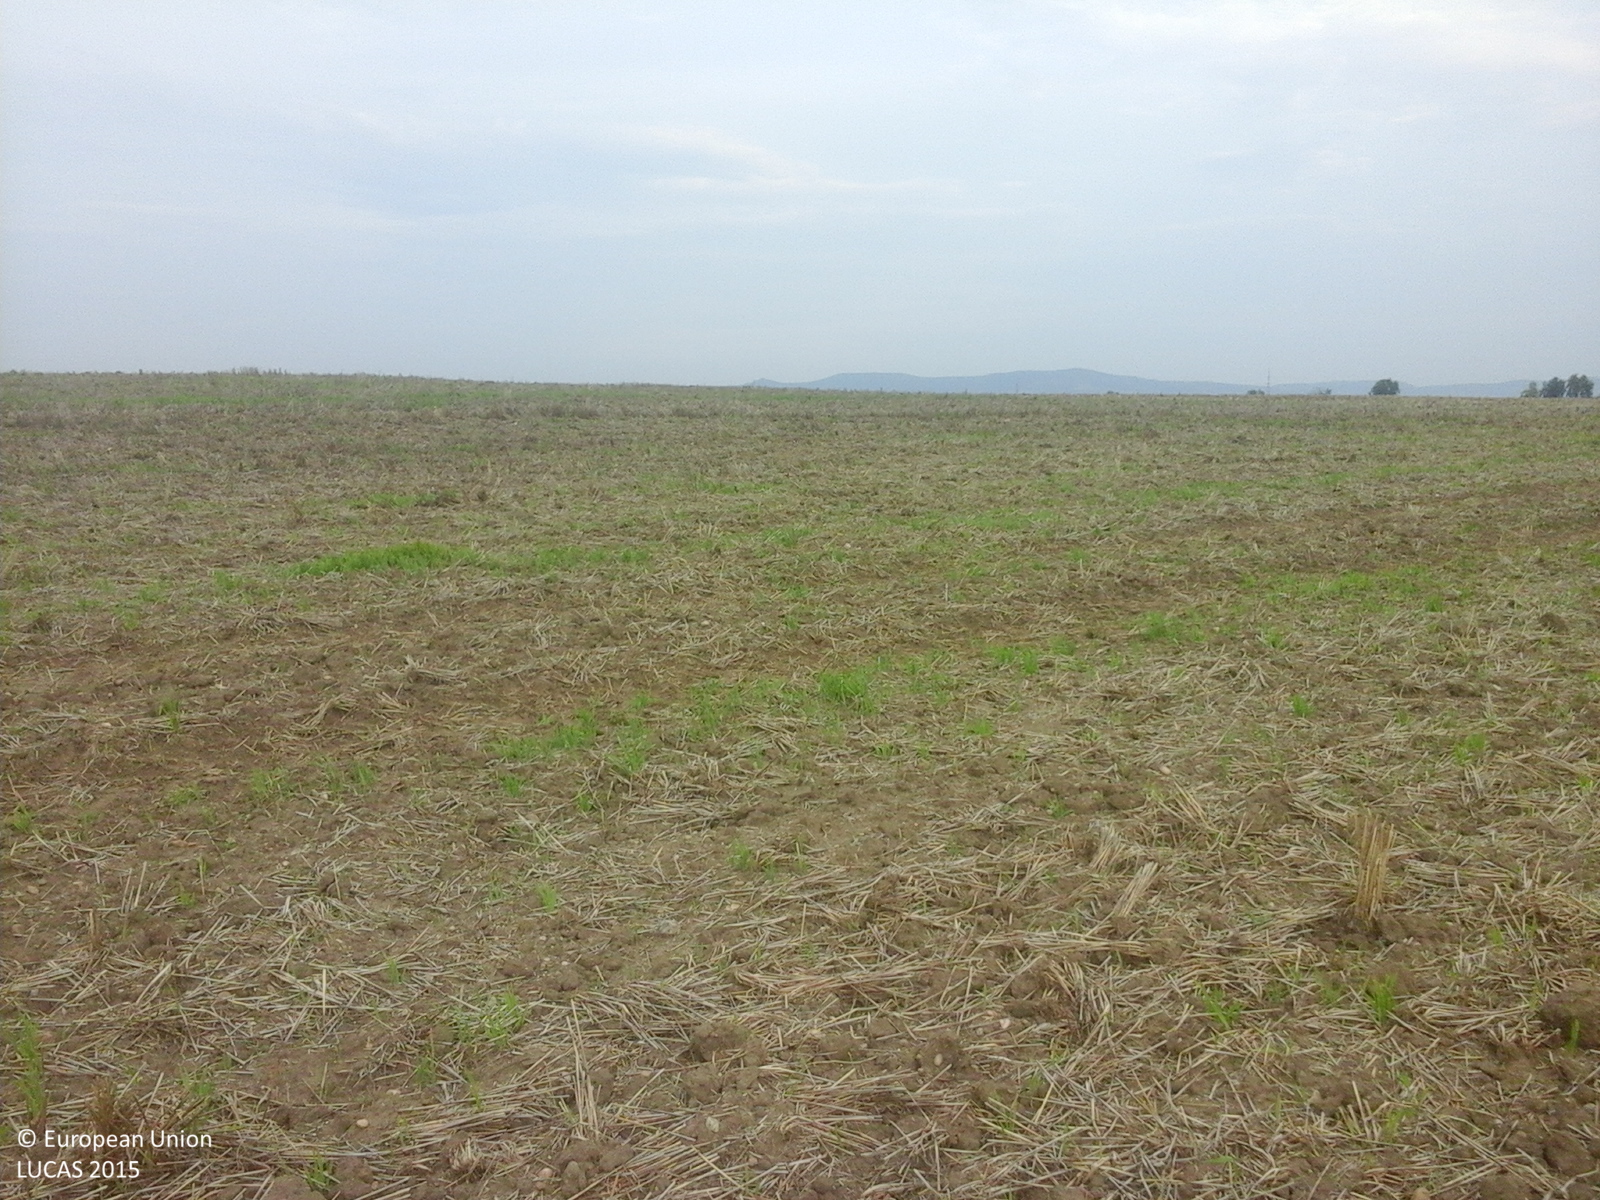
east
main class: Cropland
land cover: Common wheat
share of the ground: < 10 %
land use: Agriculture (excluding fallow land and kitchen gardens)
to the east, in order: Common wheat
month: August
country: RO
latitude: 46.2215
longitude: 21.4836
